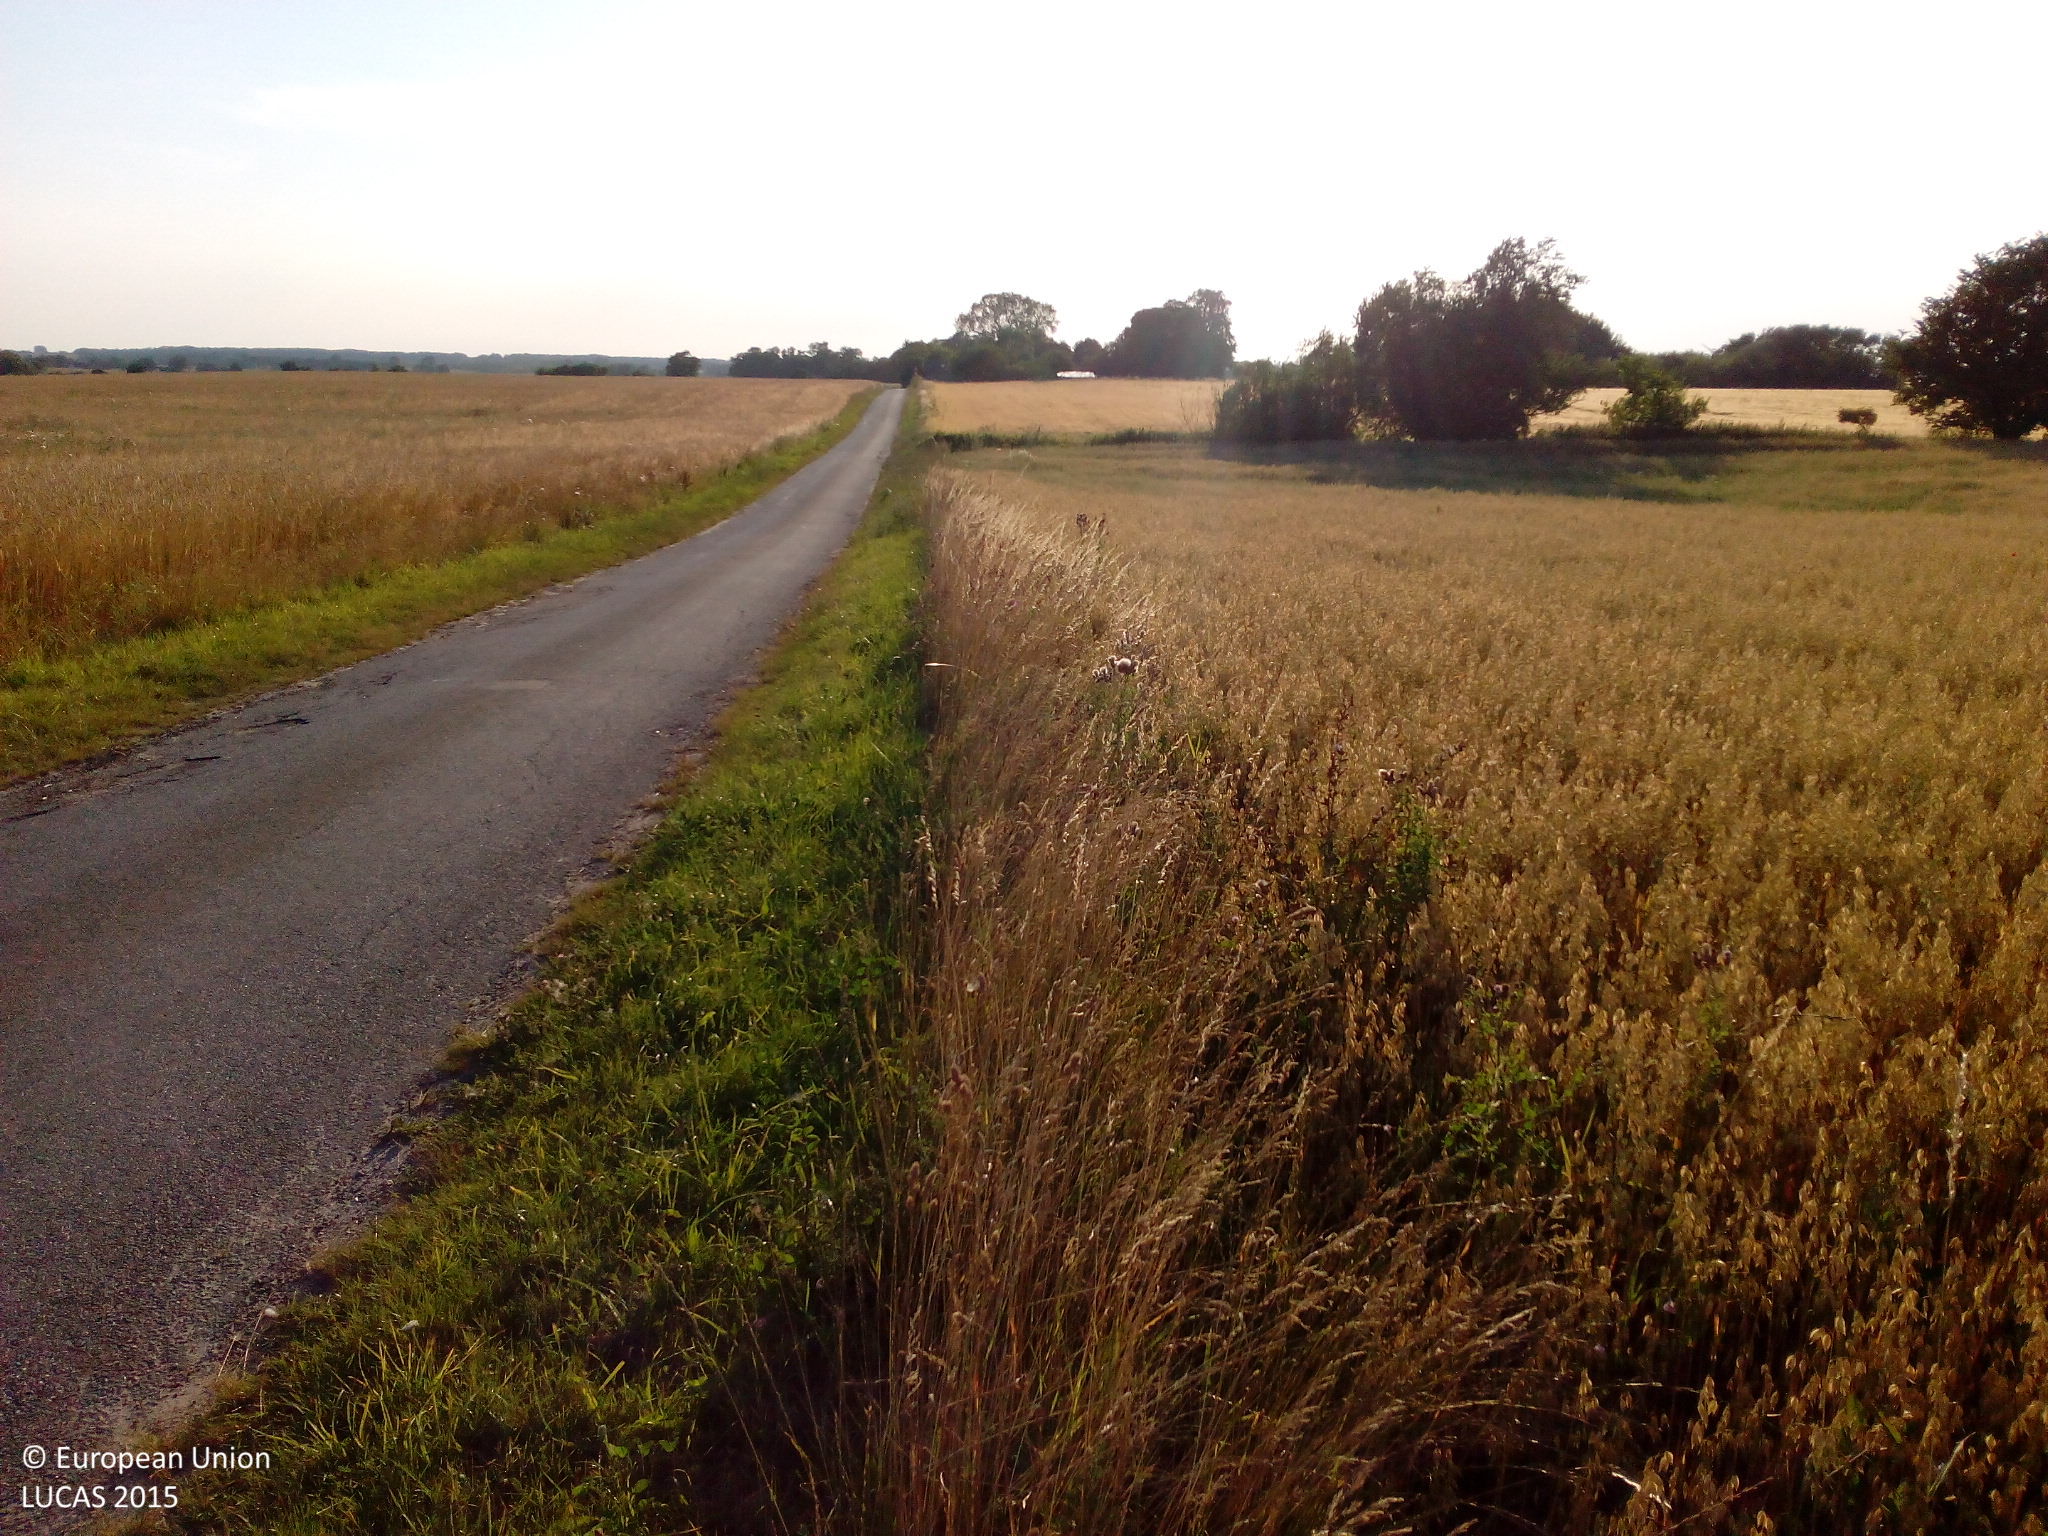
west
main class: Cropland
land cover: Oats
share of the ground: > 75 %
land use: Agriculture (excluding fallow land and kitchen gardens)
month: August
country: DK
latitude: 55.6699
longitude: 11.9221
